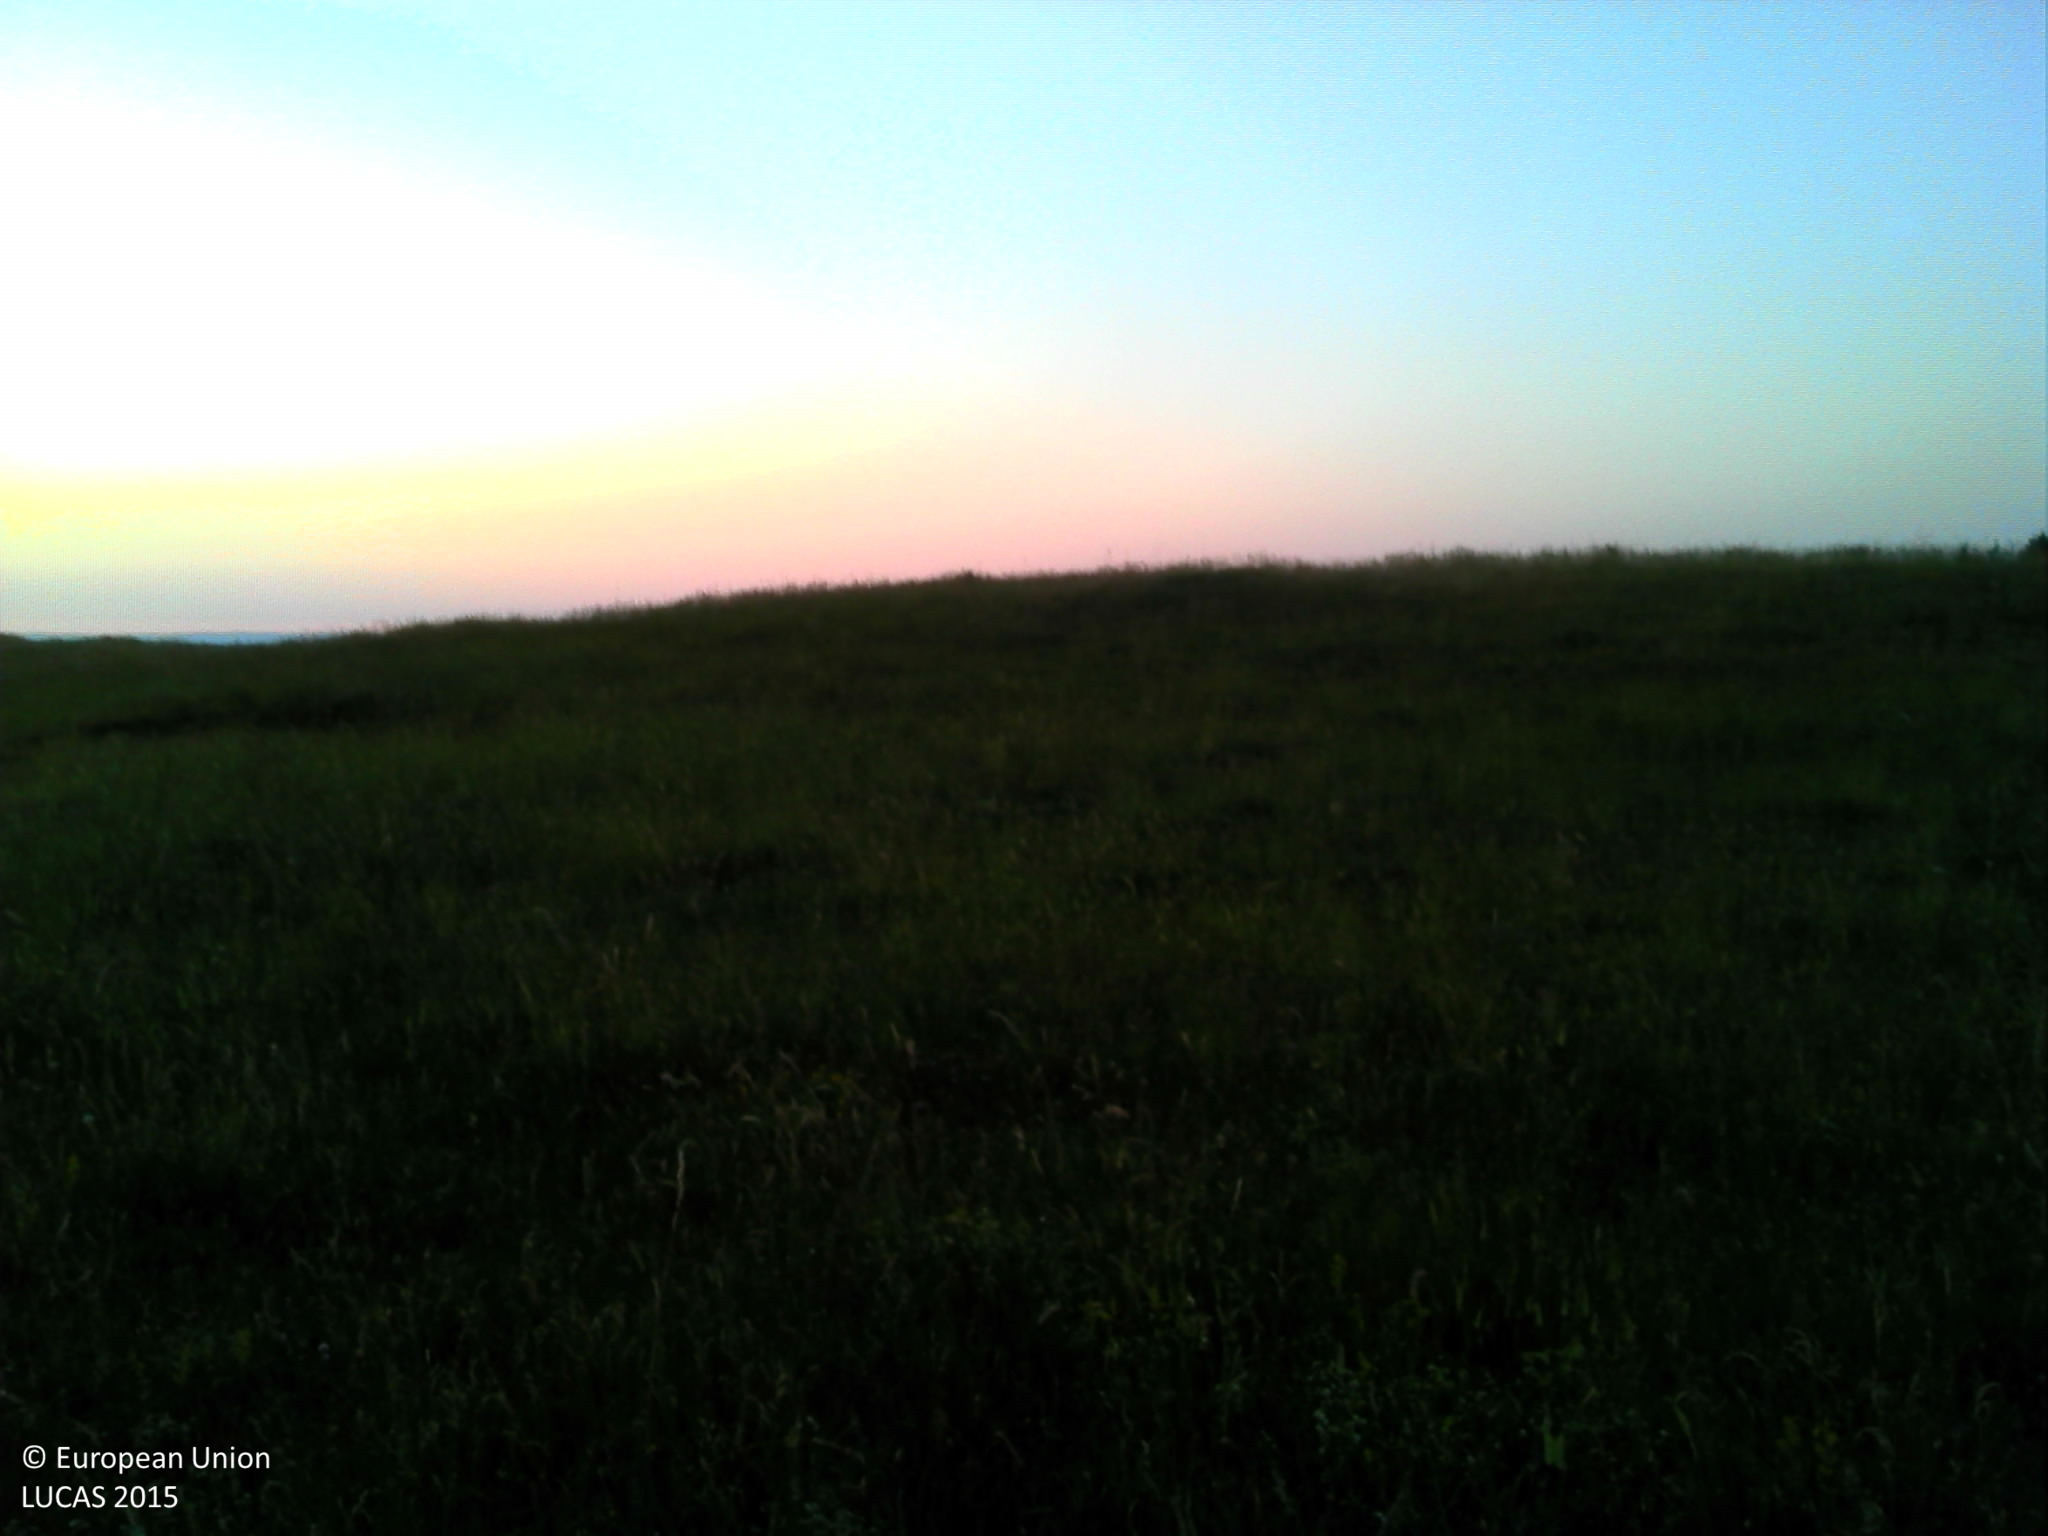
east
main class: Grassland
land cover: Grassland without tree/shrub cover
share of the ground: > 75 %
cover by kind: herbaceous plants 100 %
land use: Agriculture (excluding fallow land and kitchen gardens)
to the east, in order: Grassland without tree/shrub cover; Fences; Grassland without tree/shrub cover
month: July
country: FR
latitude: 44.6914
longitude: 2.9748
